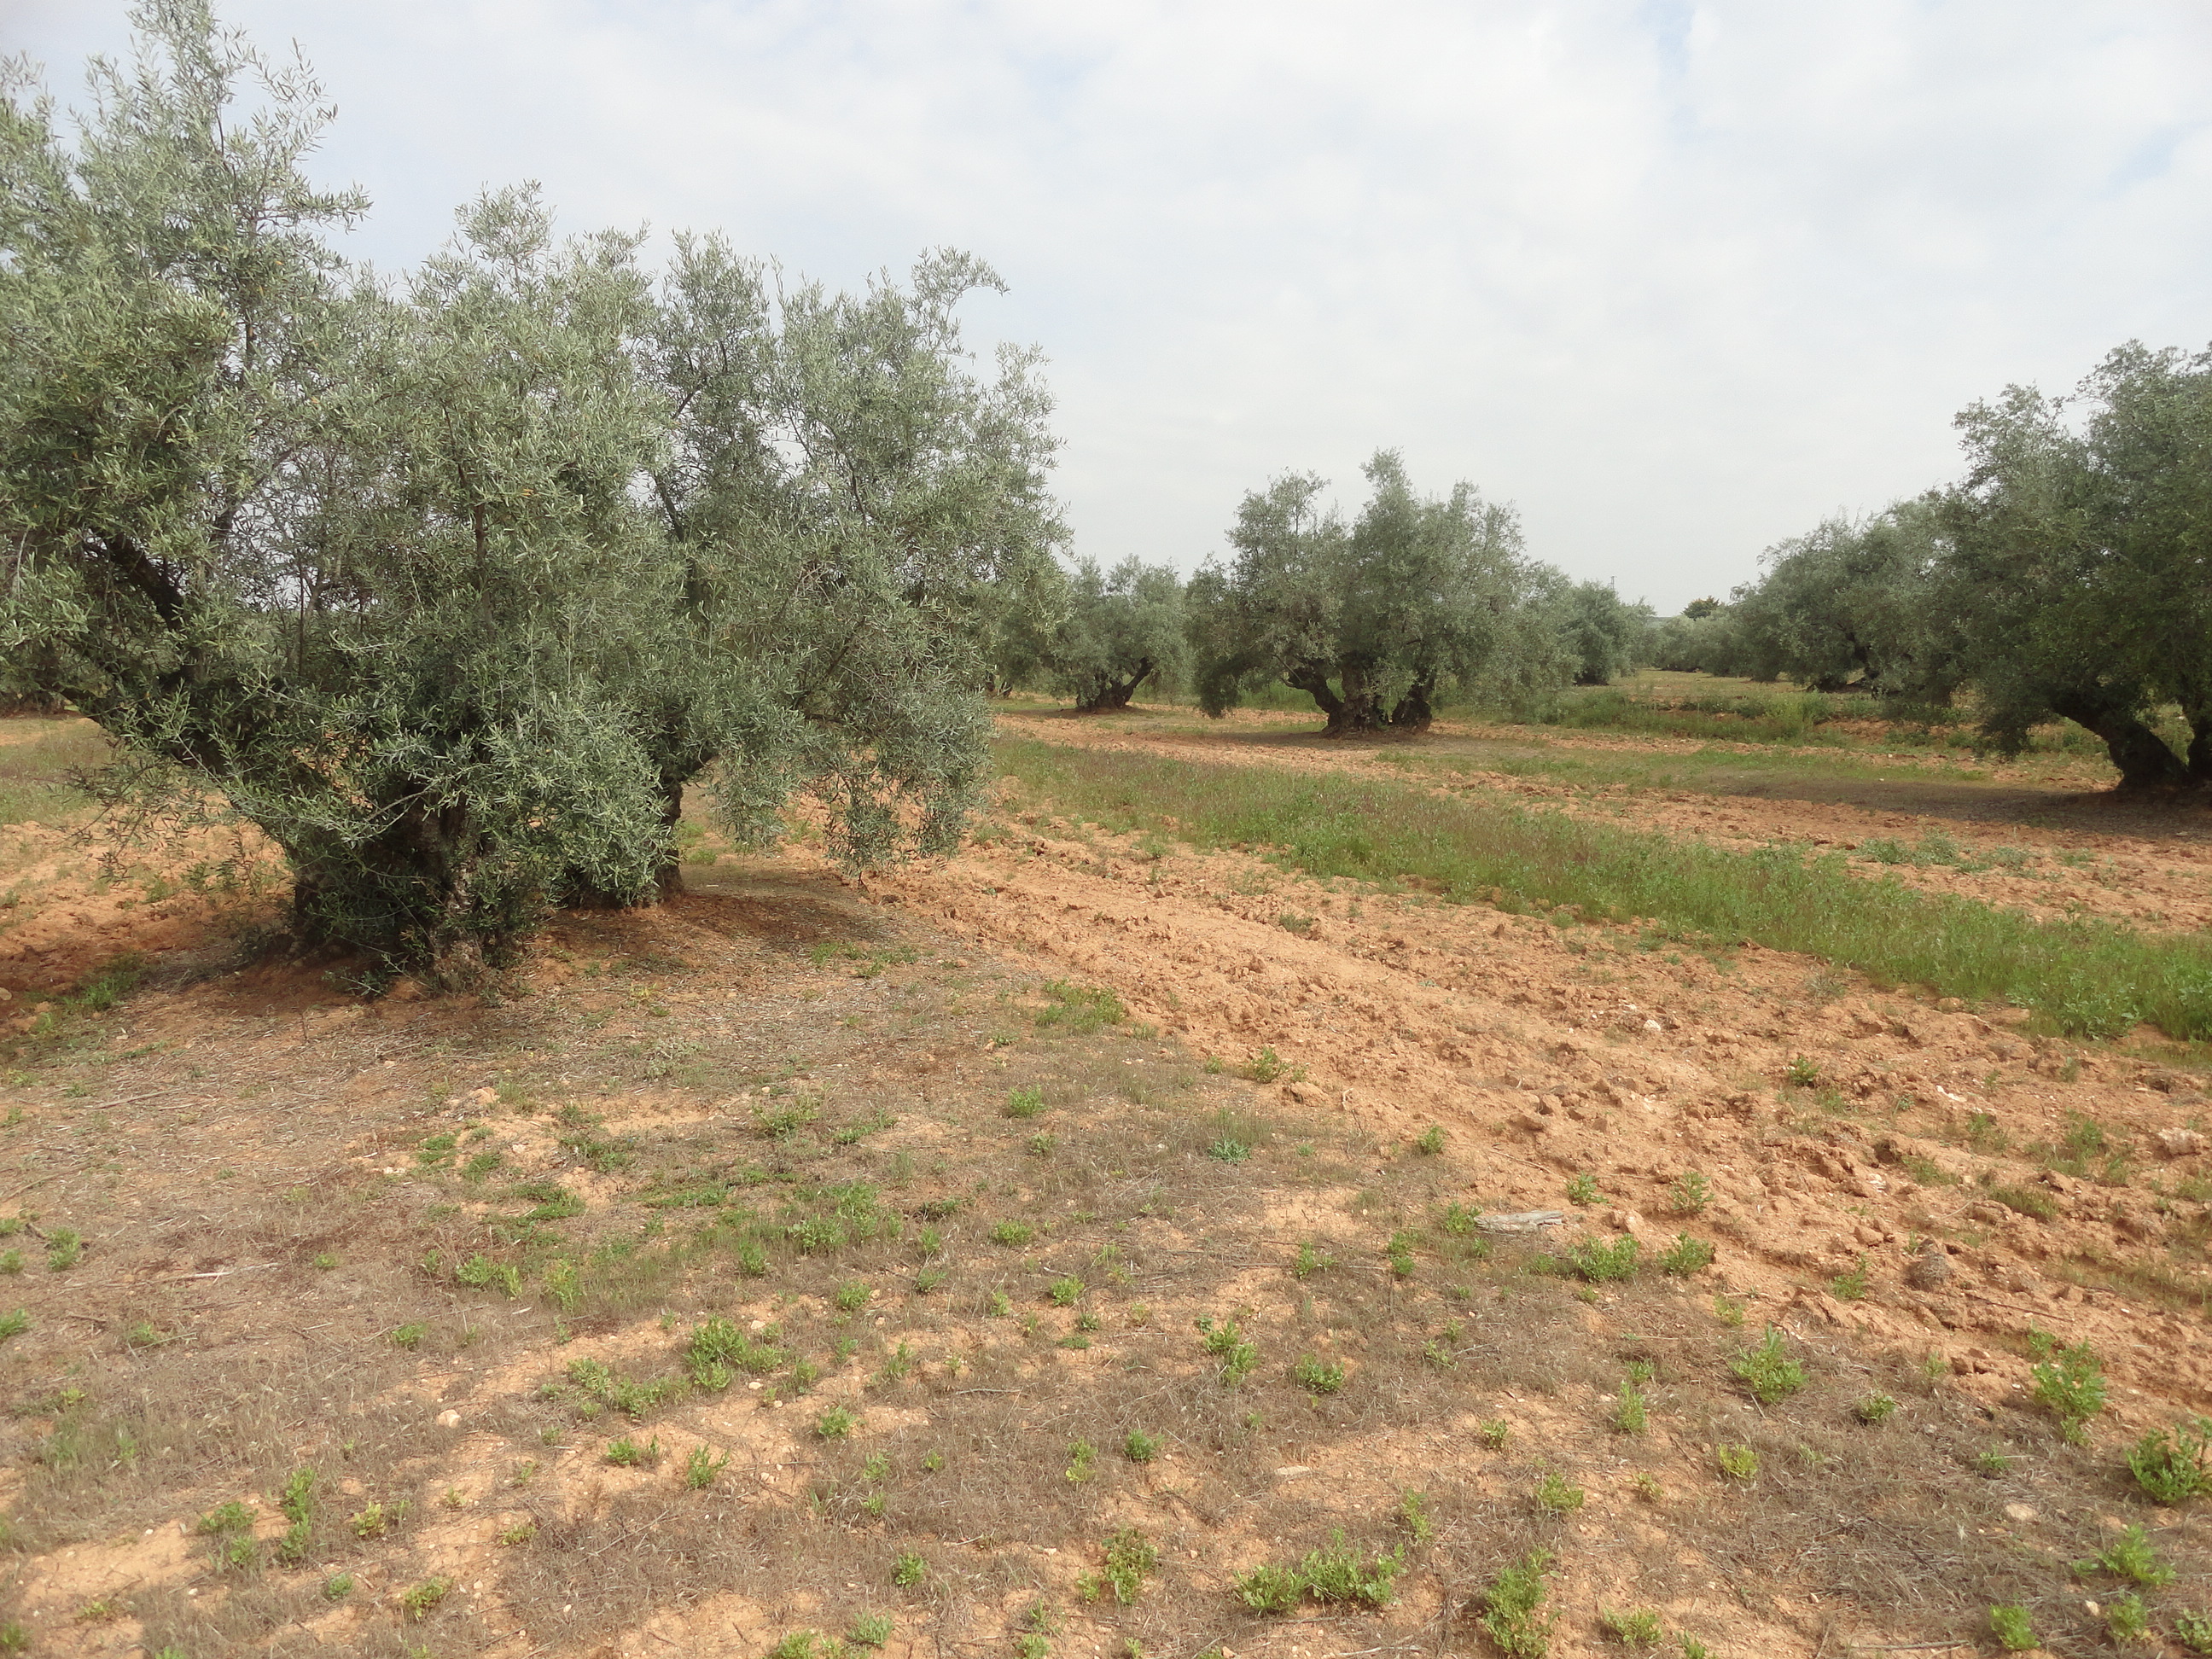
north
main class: Cropland
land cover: Olive groves
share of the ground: 25 - 50 %
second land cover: Spontaneously vegetated surfaces
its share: 50 - 75 %
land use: Agriculture (excluding fallow land and kitchen gardens)
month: April
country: ES
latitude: 37.5204
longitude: -4.5674
